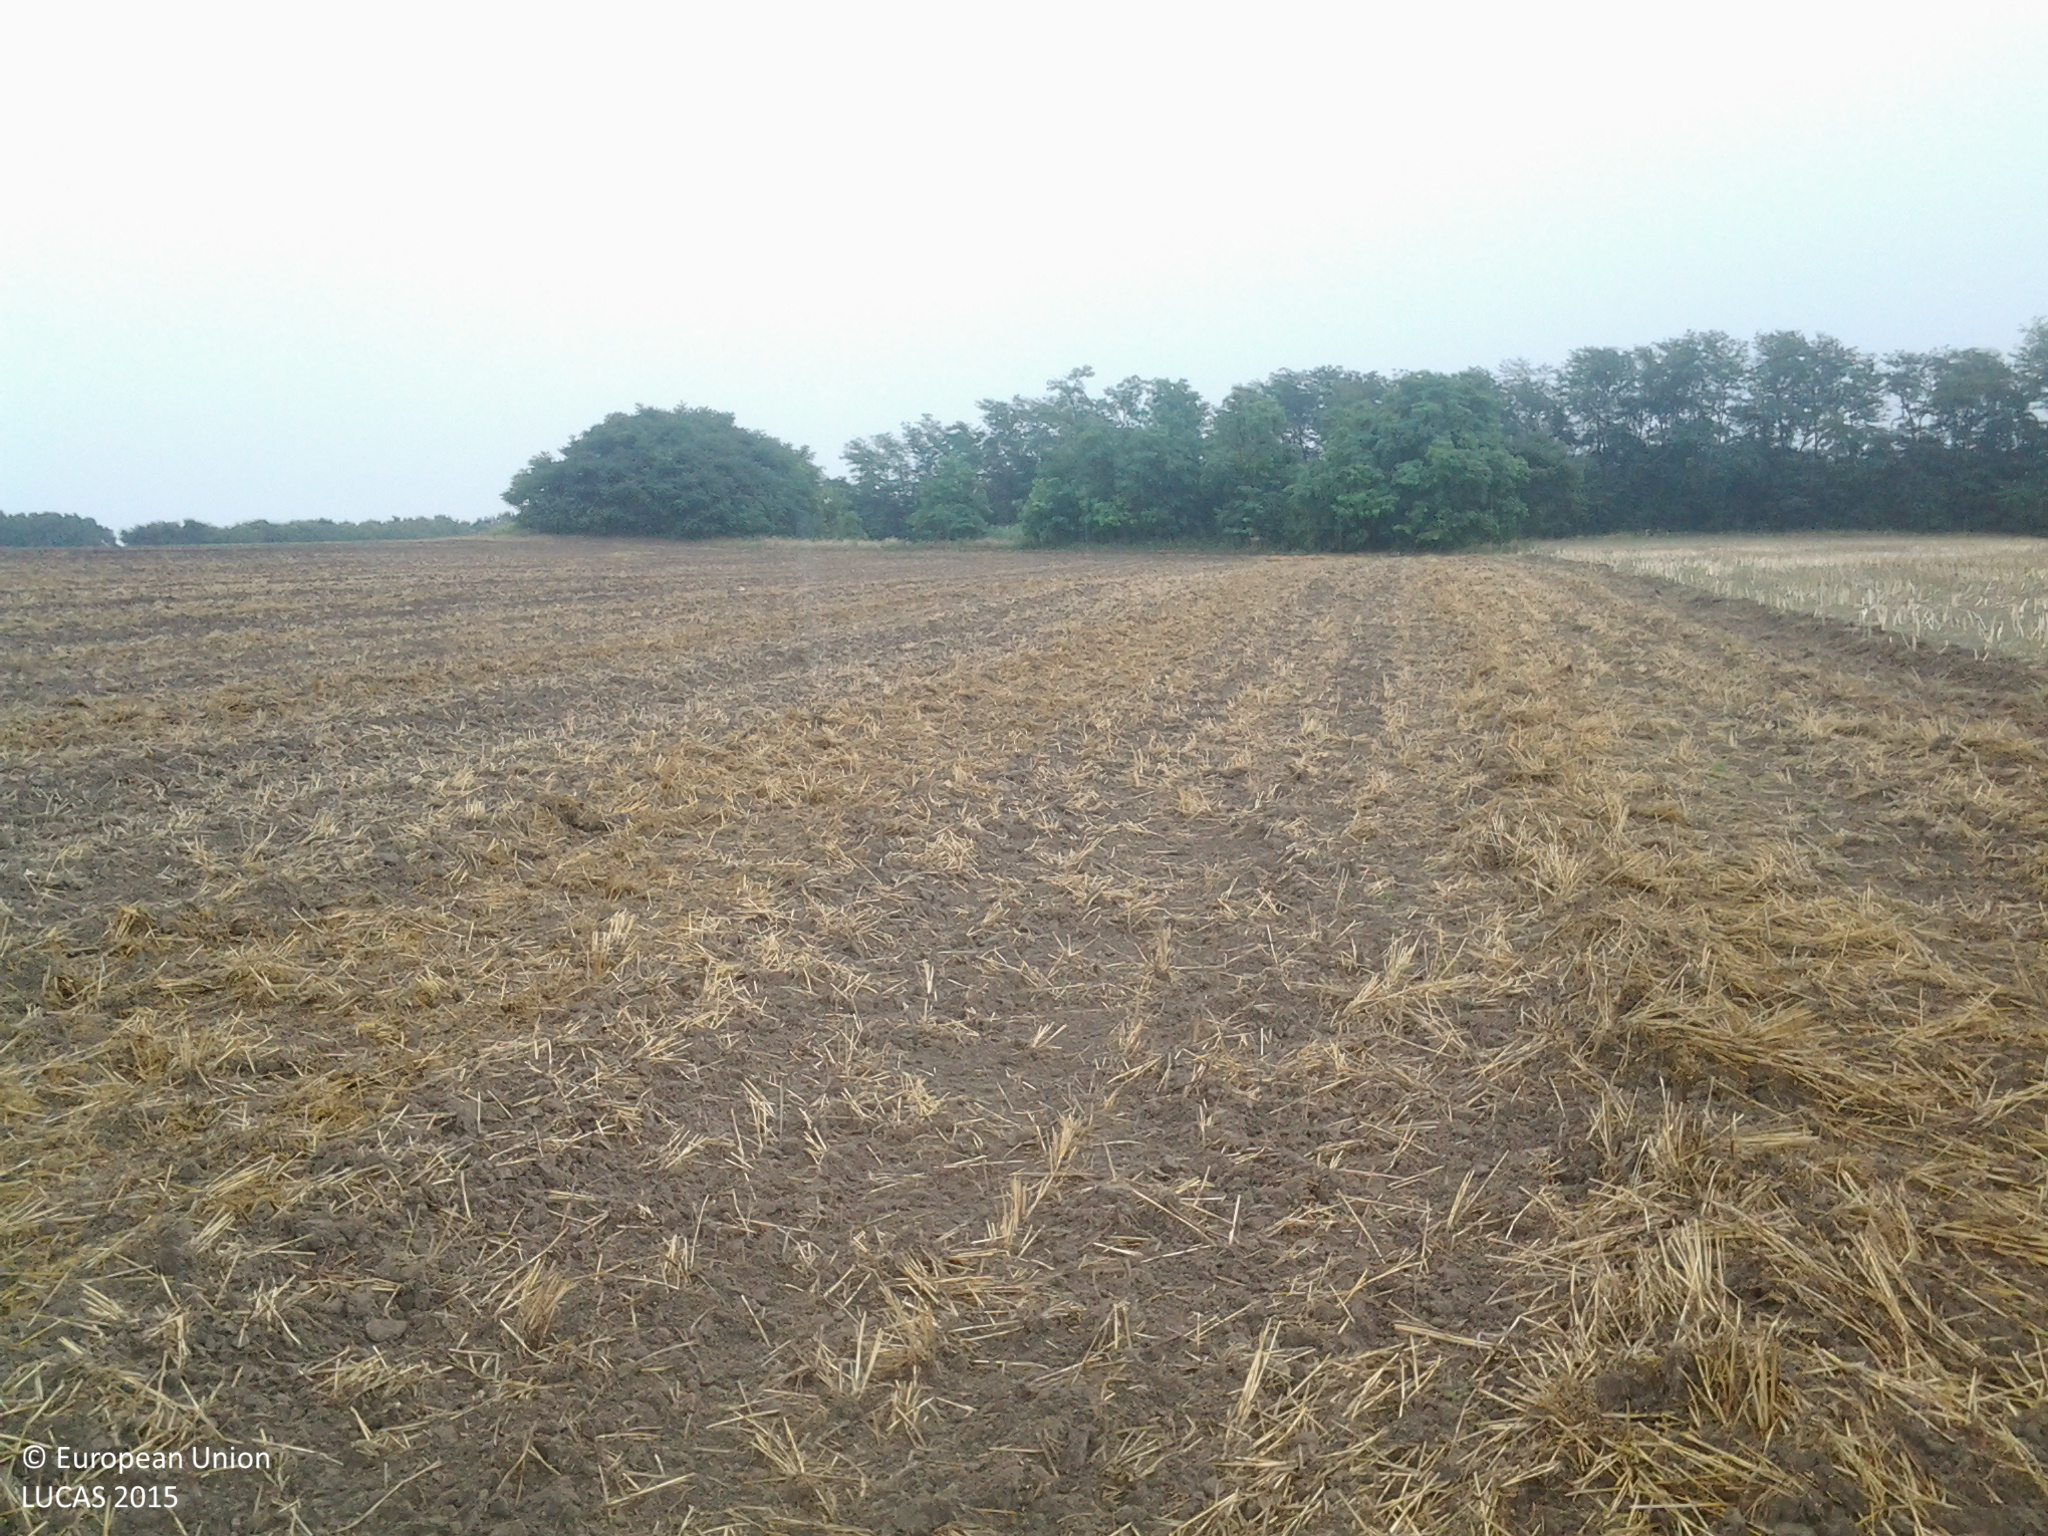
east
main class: Cropland
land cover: Common wheat
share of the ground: < 10 %
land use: Agriculture (excluding fallow land and kitchen gardens)
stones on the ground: < 10 %
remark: Harvested field
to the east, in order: Common wheat; Oats; Broadleaved woodland; Spontaneously vegetated surfaces; Grassland without tree/shrub cover
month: July
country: HU
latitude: 46.9838
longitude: 19.0215
